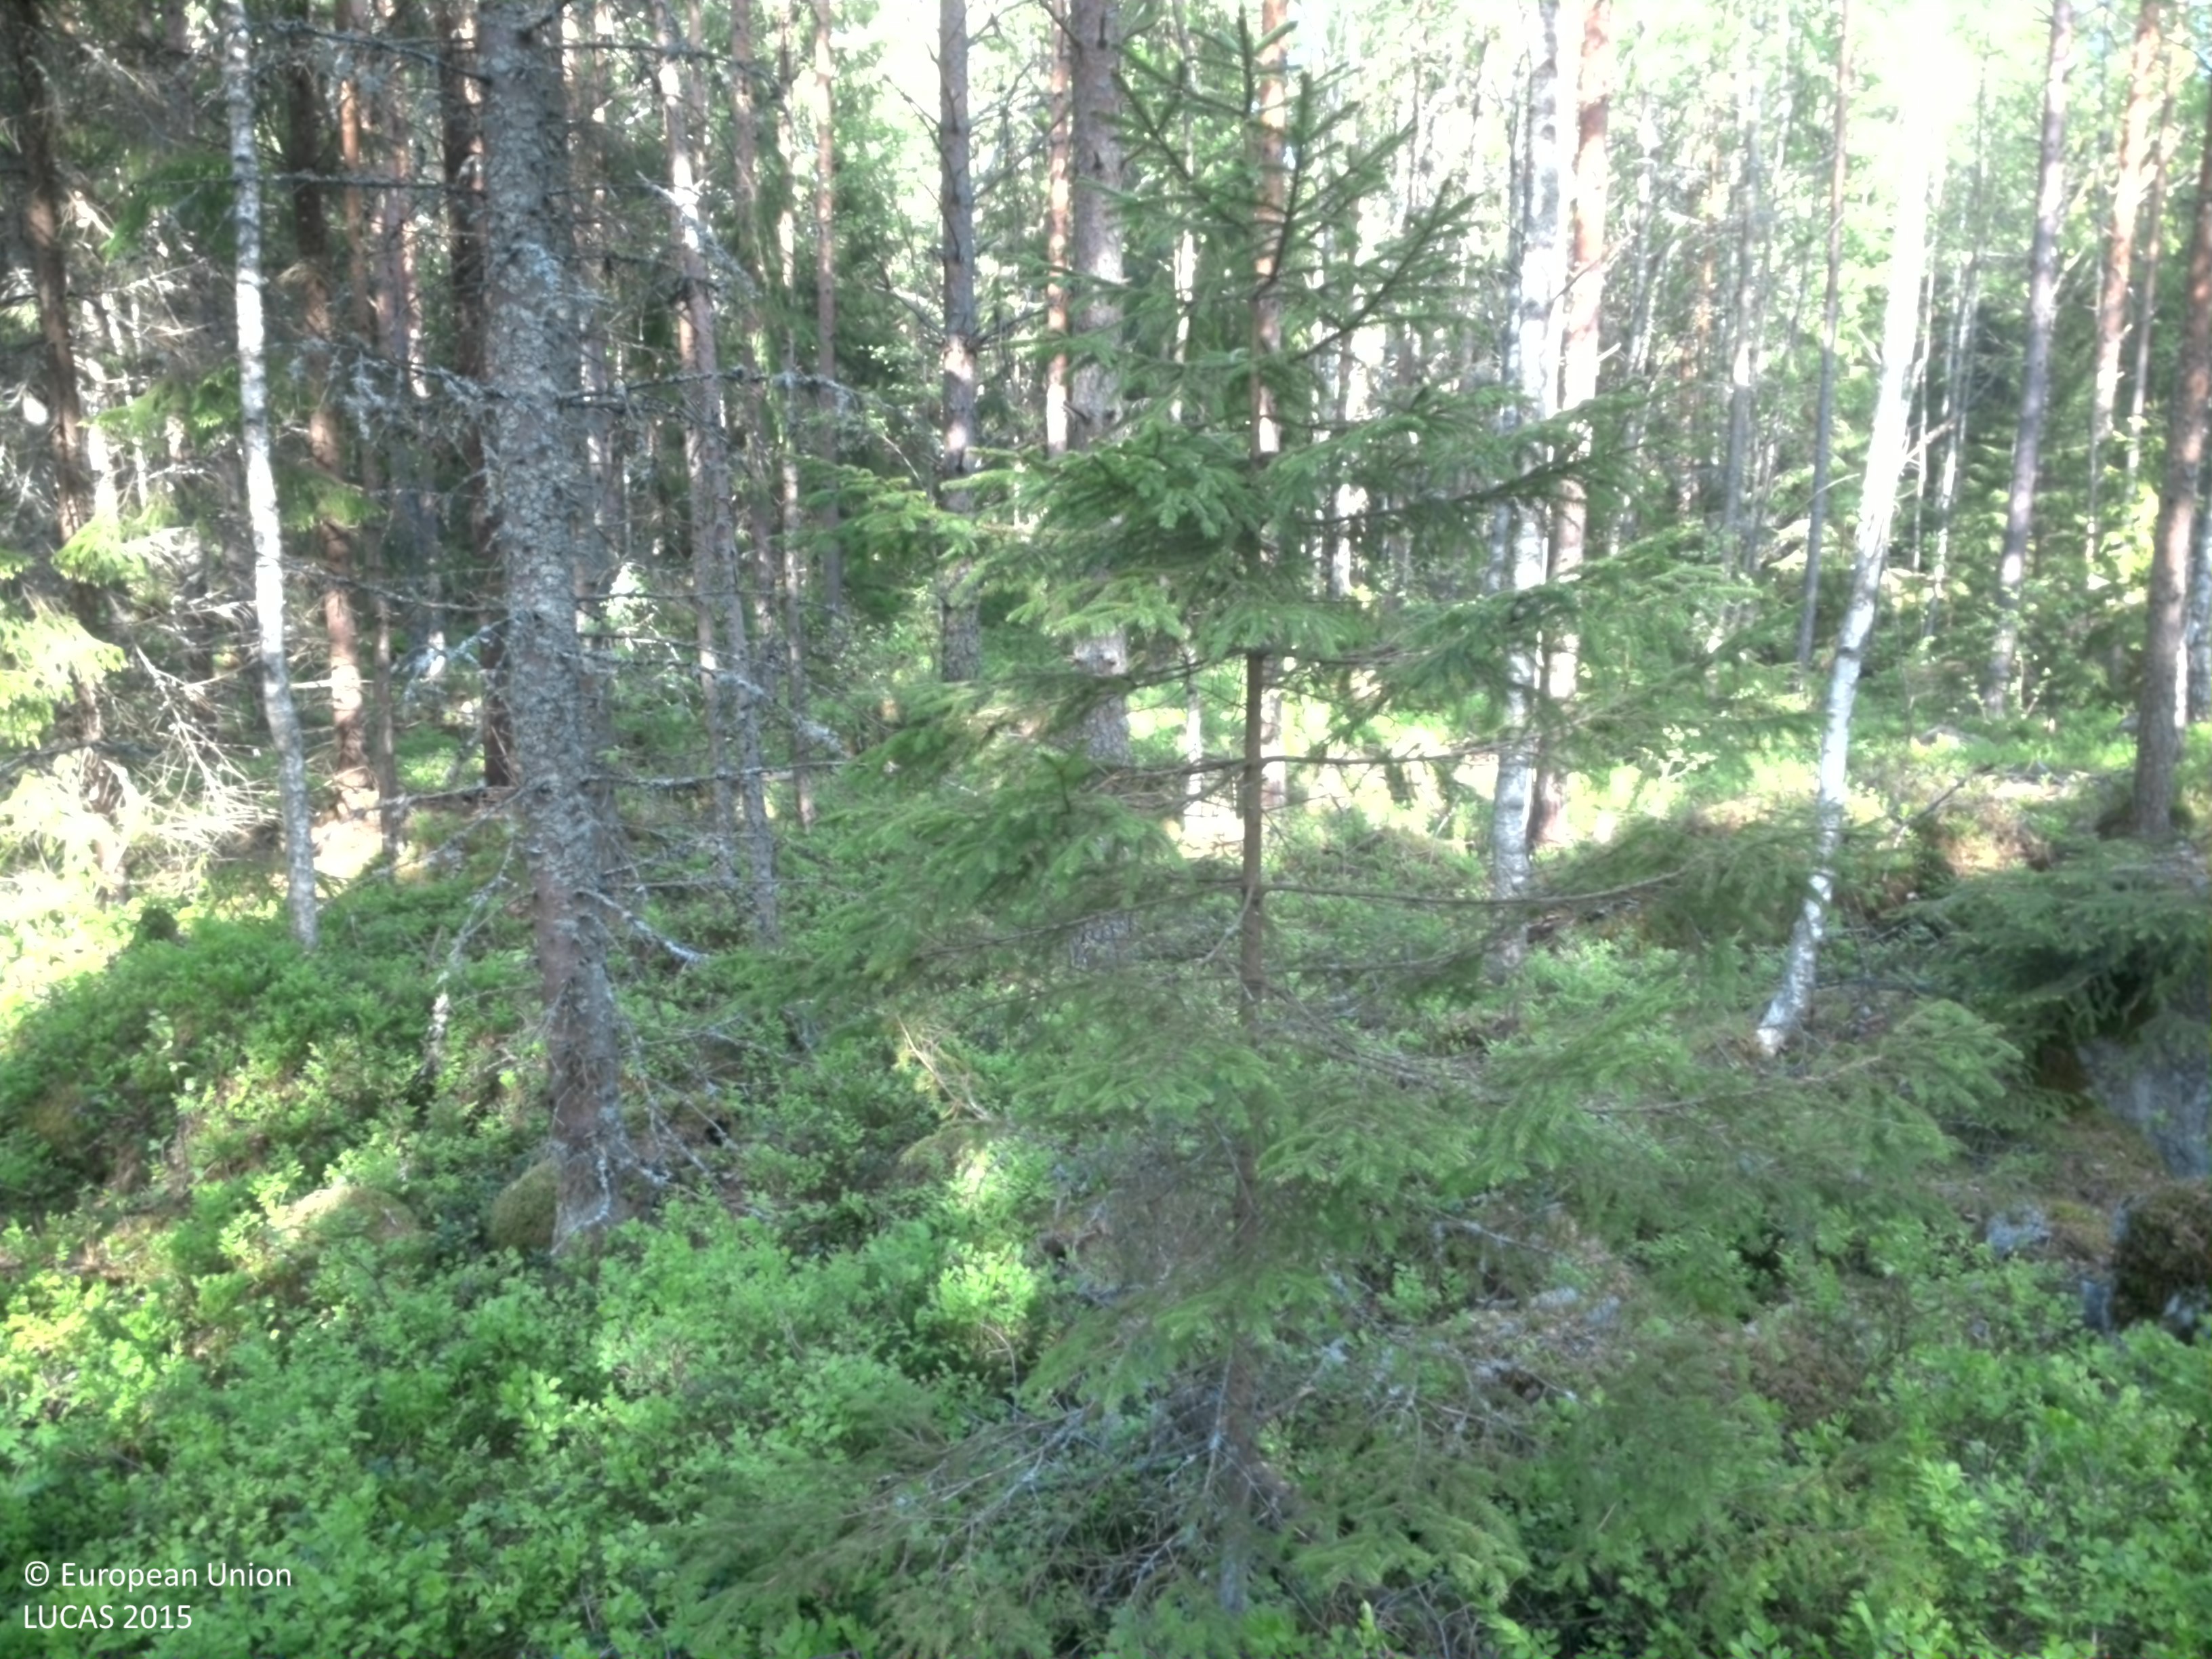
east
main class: Woodland
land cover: Pine dominated mixed woodland
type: boreal forest
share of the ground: 50 - 75 %
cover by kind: coniferous forest trees 40 %, broadleaved forest trees 25 %, shrubs 15 %, lichens and mosses 10 %, consolidated bare surface 10 %
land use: Forestry
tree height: > 5 m
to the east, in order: Pine dominated mixed woodland; Spruce dominated mixed woodland; Tracks; Other coniferous woodland; Spruce dominated coniferous woodland; Tracks; Spruce dominated coniferous woodland; Ditches and canals; Pine dominated mixed woodland
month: June
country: SE
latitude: 59.2660
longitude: 14.3598
